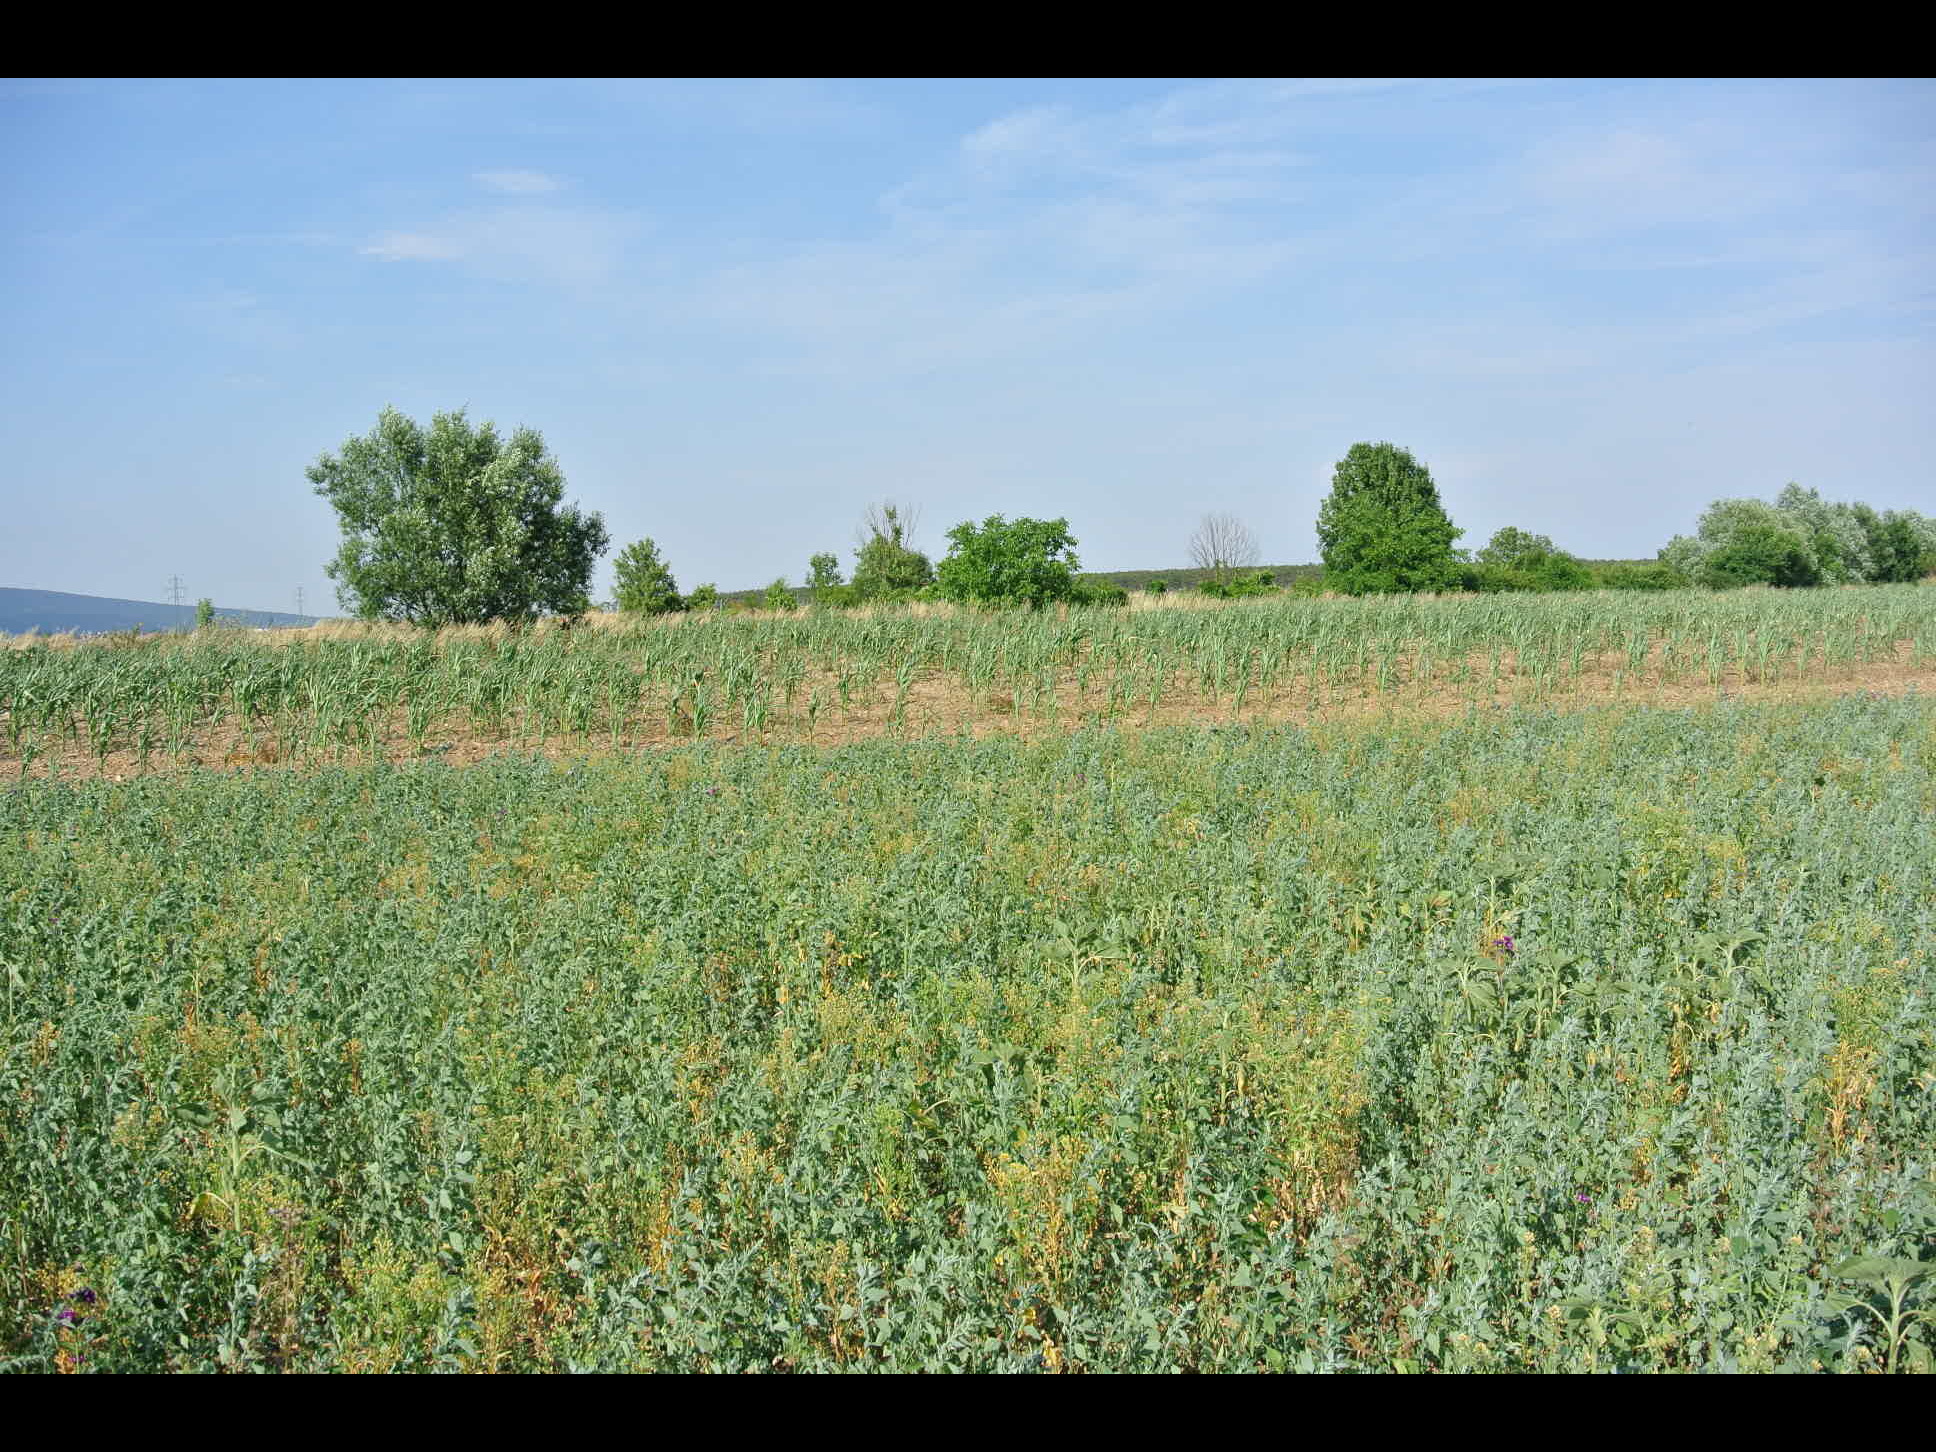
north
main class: Cropland
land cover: Common wheat
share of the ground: > 75 %
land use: Agriculture (excluding fallow land and kitchen gardens)
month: July
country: AT
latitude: 47.7823
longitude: 16.1294
